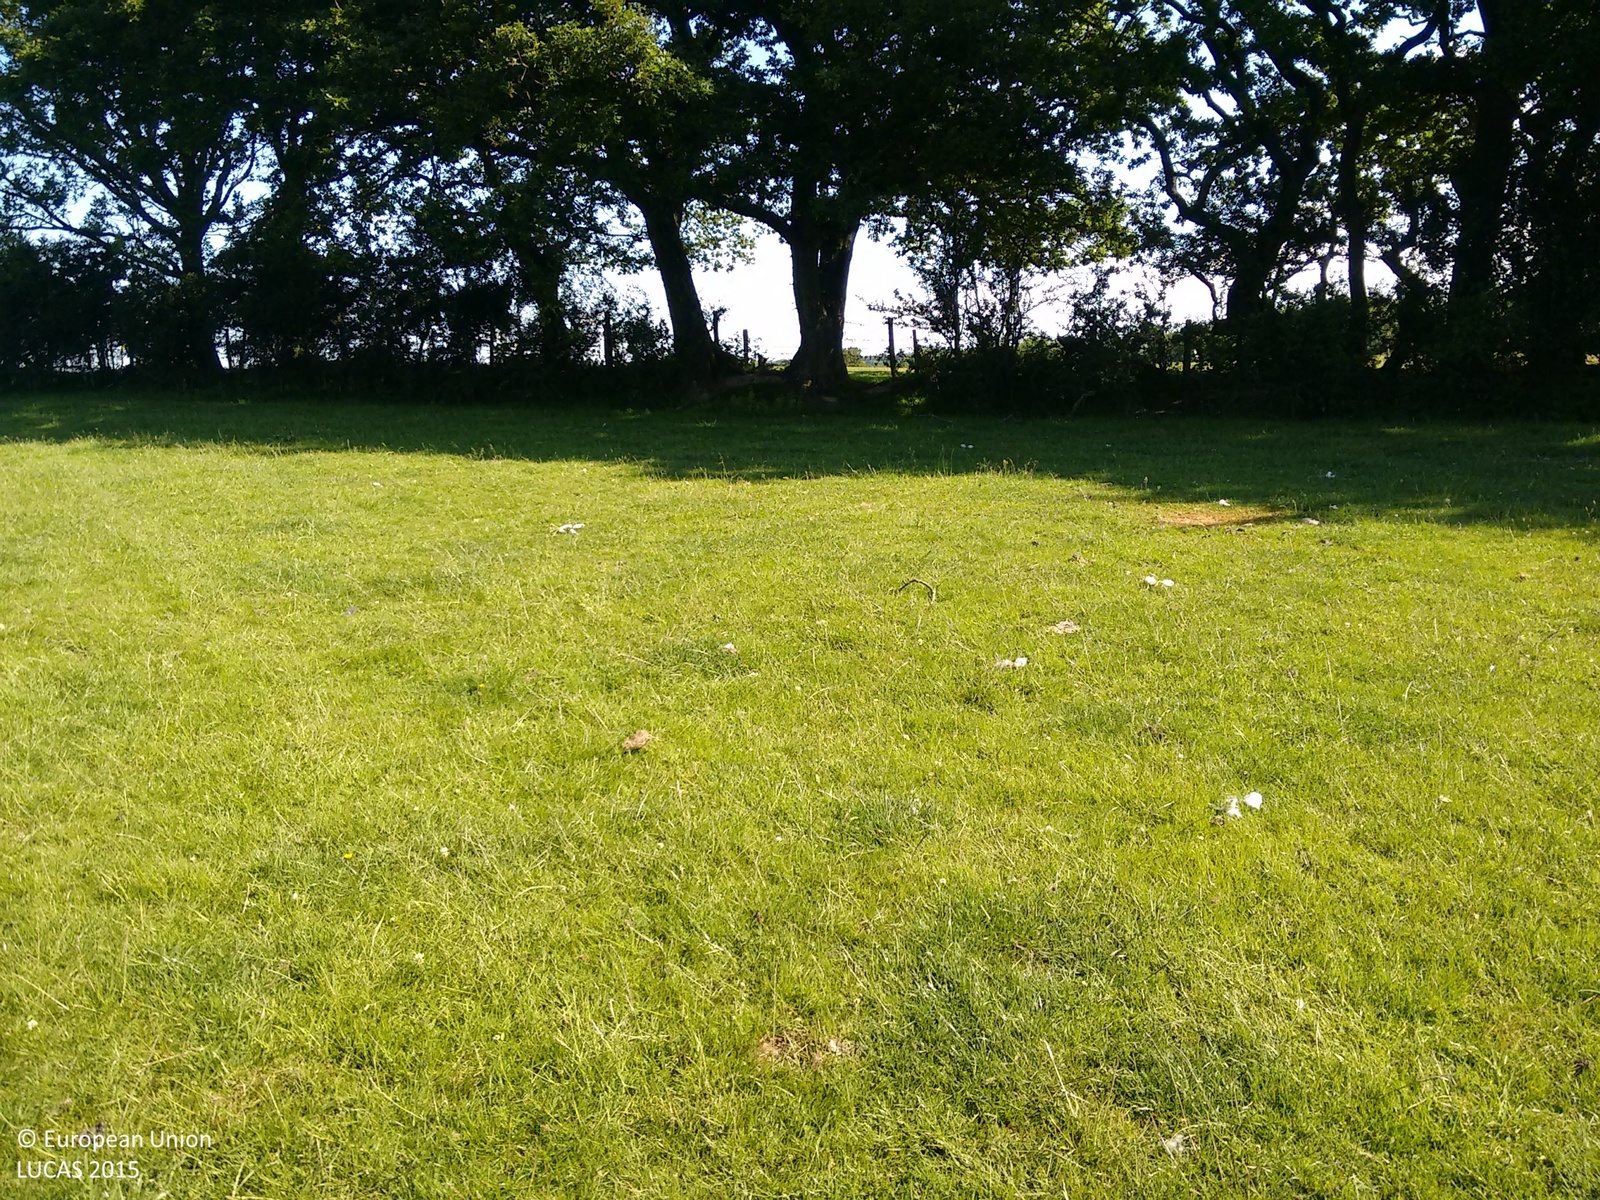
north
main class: Grassland
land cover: Grassland without tree/shrub cover
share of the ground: > 75 %
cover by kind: herbaceous plants 100 %
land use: Agriculture (excluding fallow land and kitchen gardens)
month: June
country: GB
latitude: 50.8974
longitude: 0.5746
